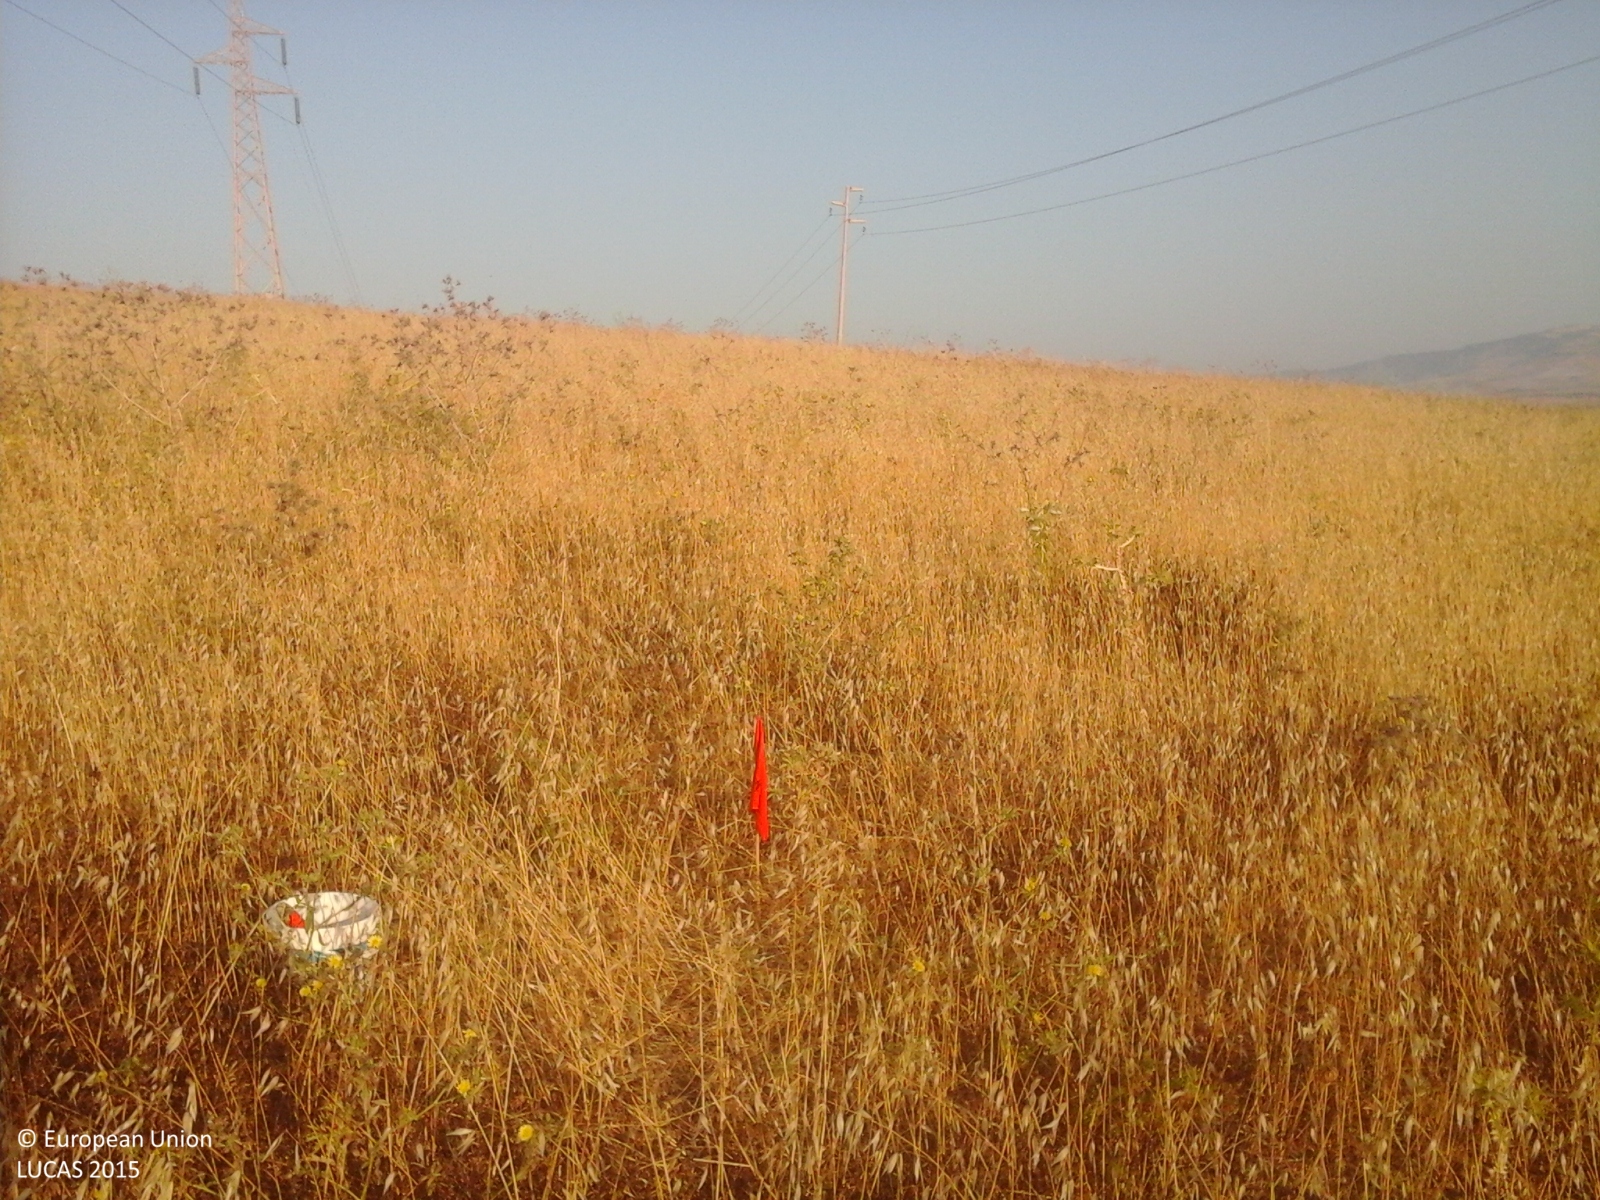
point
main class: Grassland
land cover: Spontaneously vegetated surfaces
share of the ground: > 75 %
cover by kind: herbaceous plants 100 %
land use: Fallow land
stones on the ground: > 50 %
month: July
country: IT
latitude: 37.1205
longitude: 13.9417
